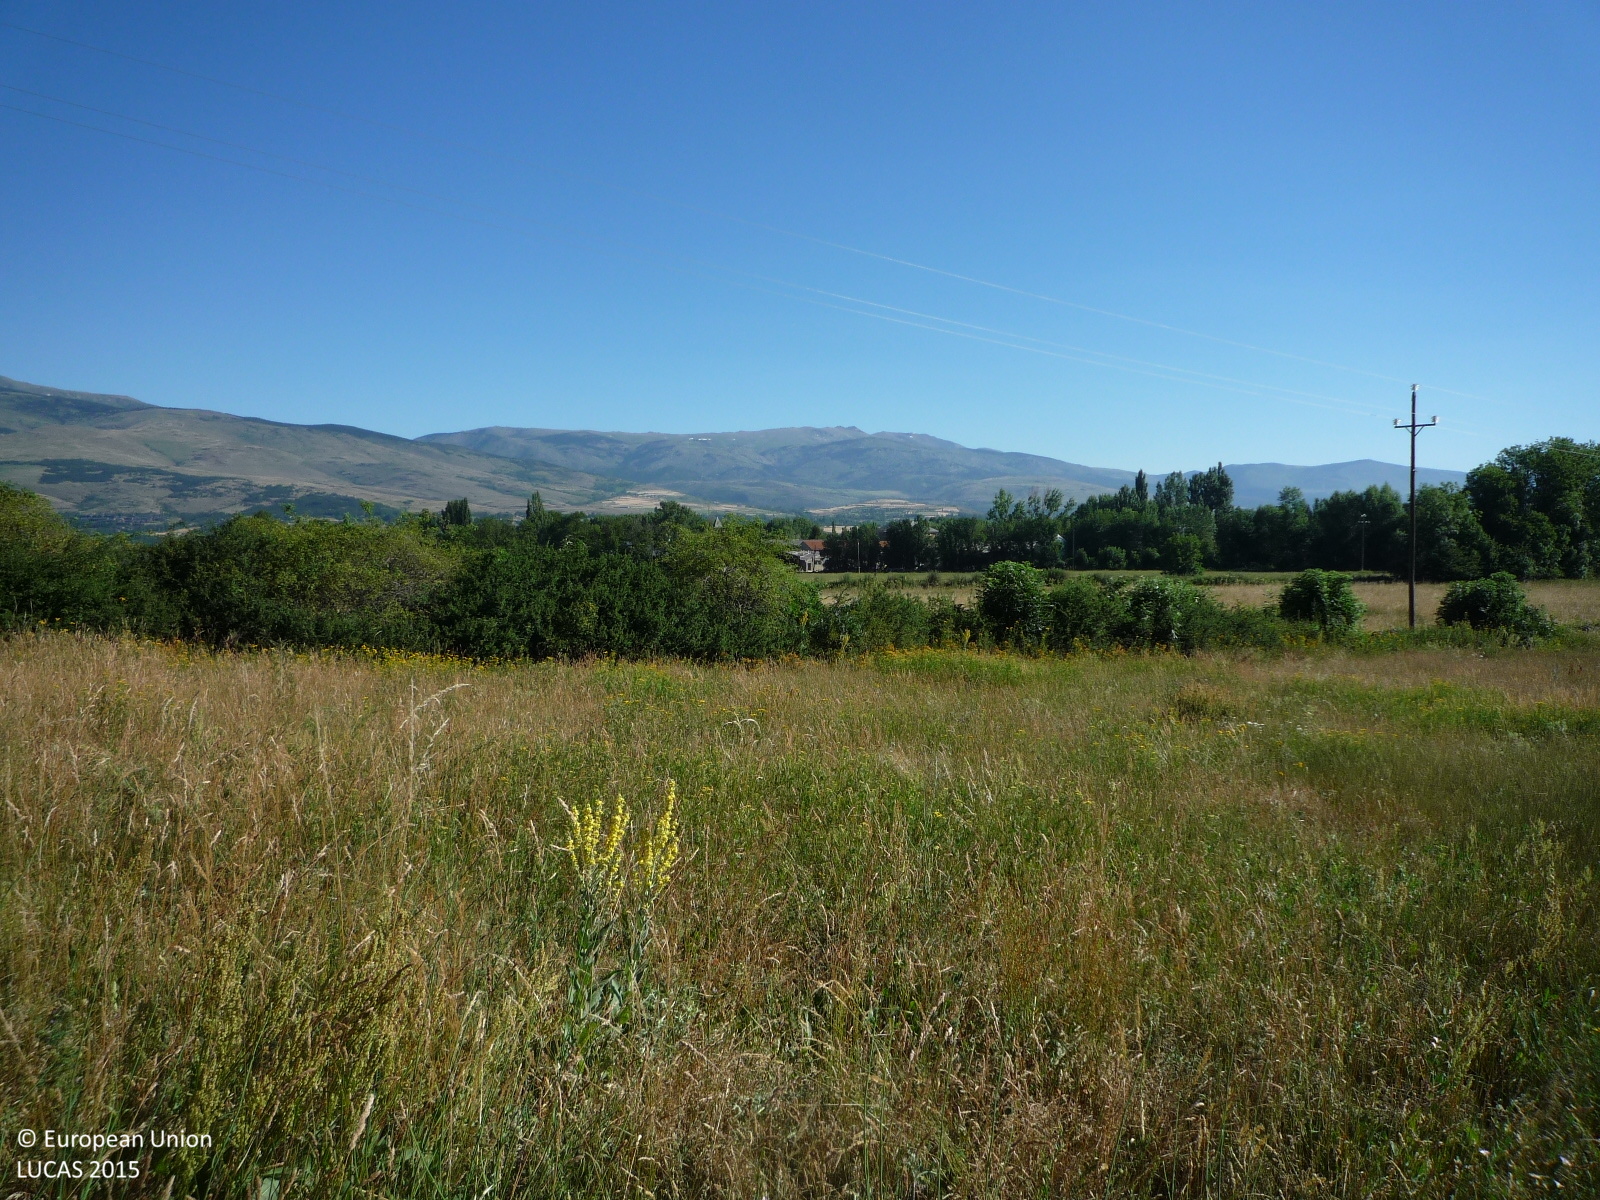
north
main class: Grassland
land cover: Spontaneously vegetated surfaces
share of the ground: > 75 %
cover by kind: herbaceous plants 100 %
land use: Fallow land
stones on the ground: 10 - 25 %
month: July
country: ES
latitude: 42.3825
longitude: 1.8857
